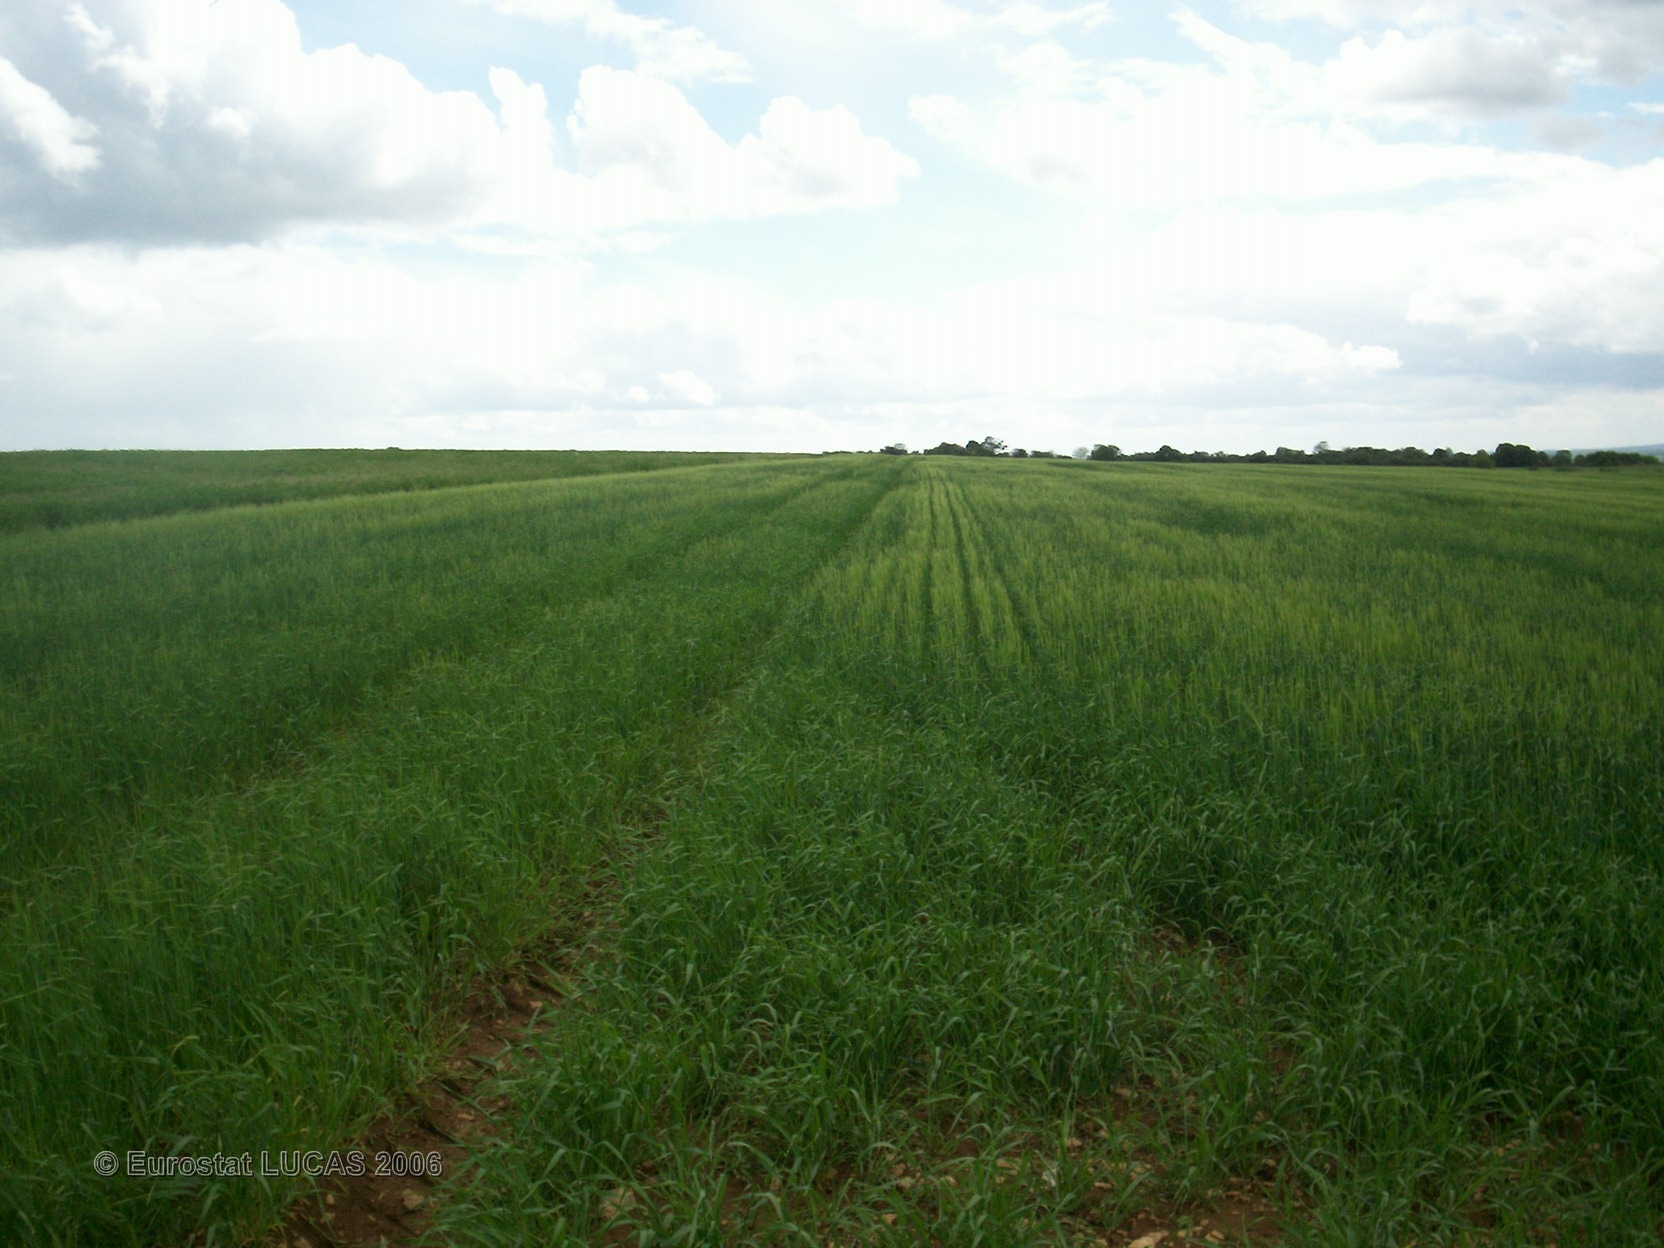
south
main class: Cropland
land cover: Barley
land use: Agriculture (excluding fallow land and kitchen gardens)
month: May
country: FR
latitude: 46.9740
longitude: 4.6243
